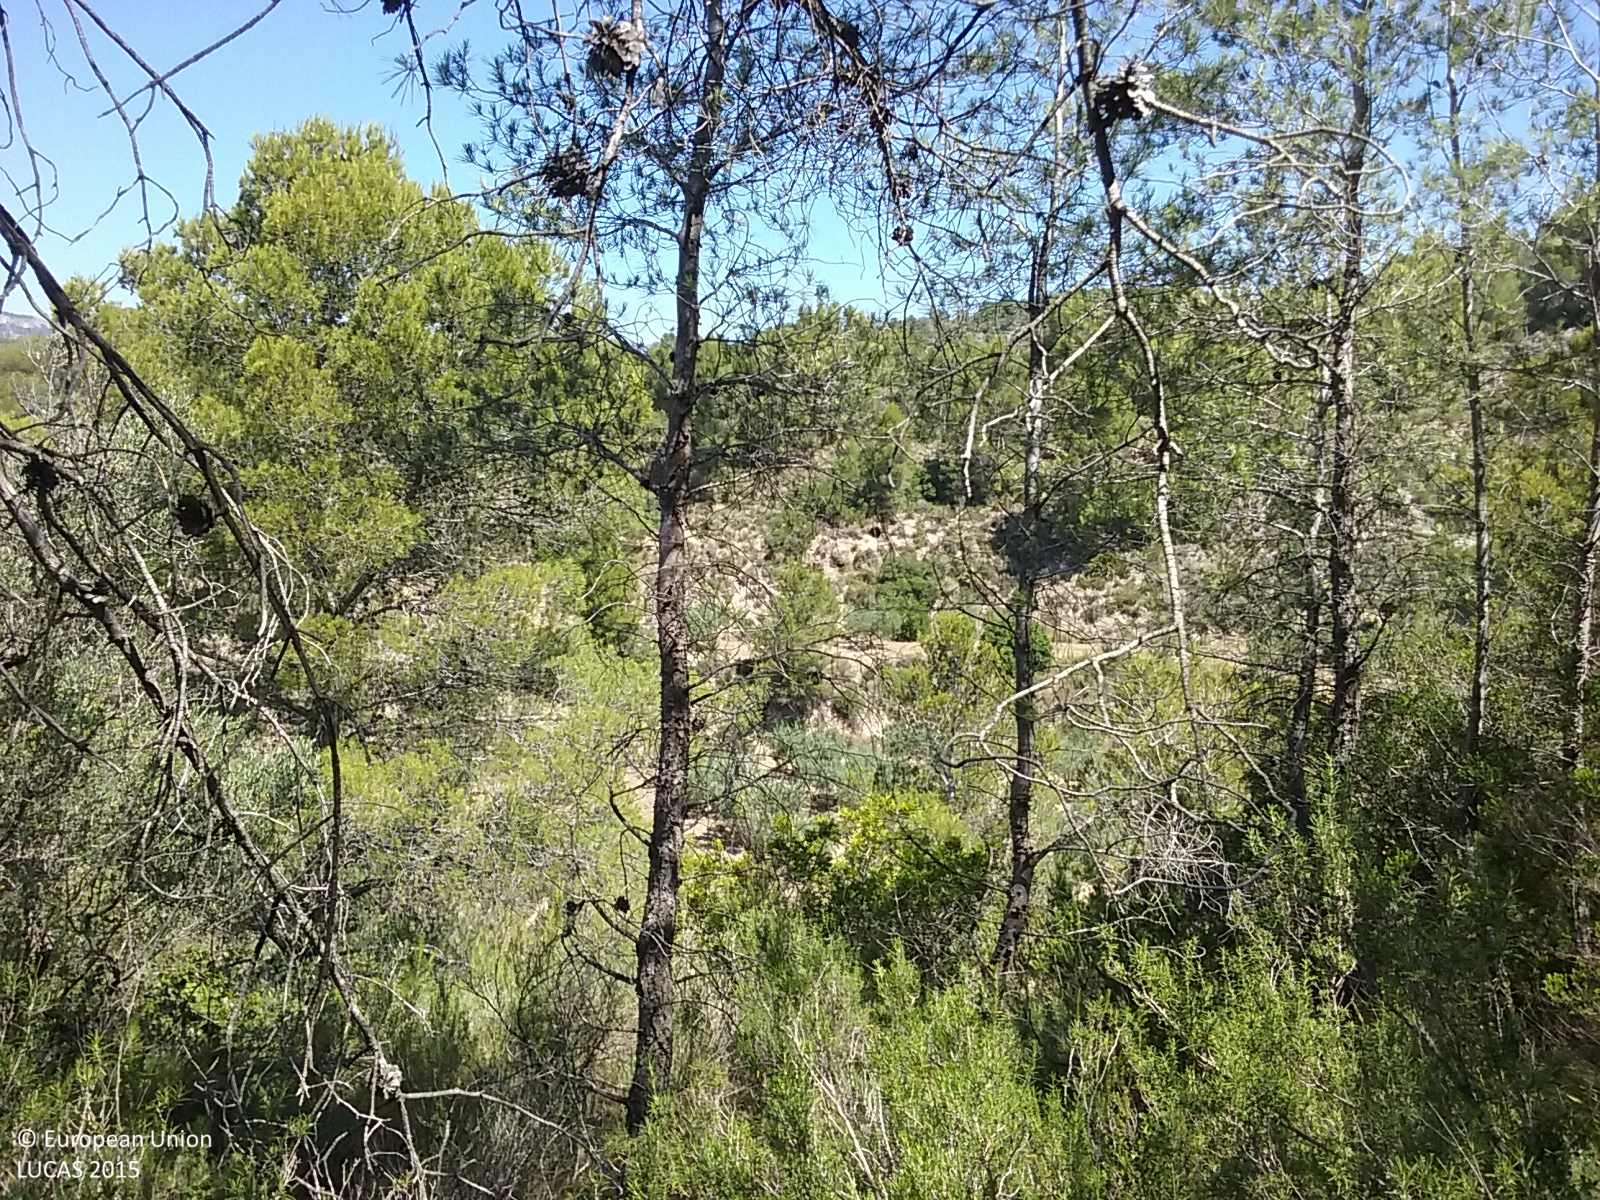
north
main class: Woodland
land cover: Pine dominated coniferous woodland
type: coniferous forest of the mediterranean region
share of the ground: 50 - 75 %
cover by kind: coniferous forest trees 55 %, herbaceous plants 25 %, shrubs 20 %
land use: Semi-natural and natural areas not in use
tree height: > 5 m
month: June
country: ES
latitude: 40.9902
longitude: 0.5186
